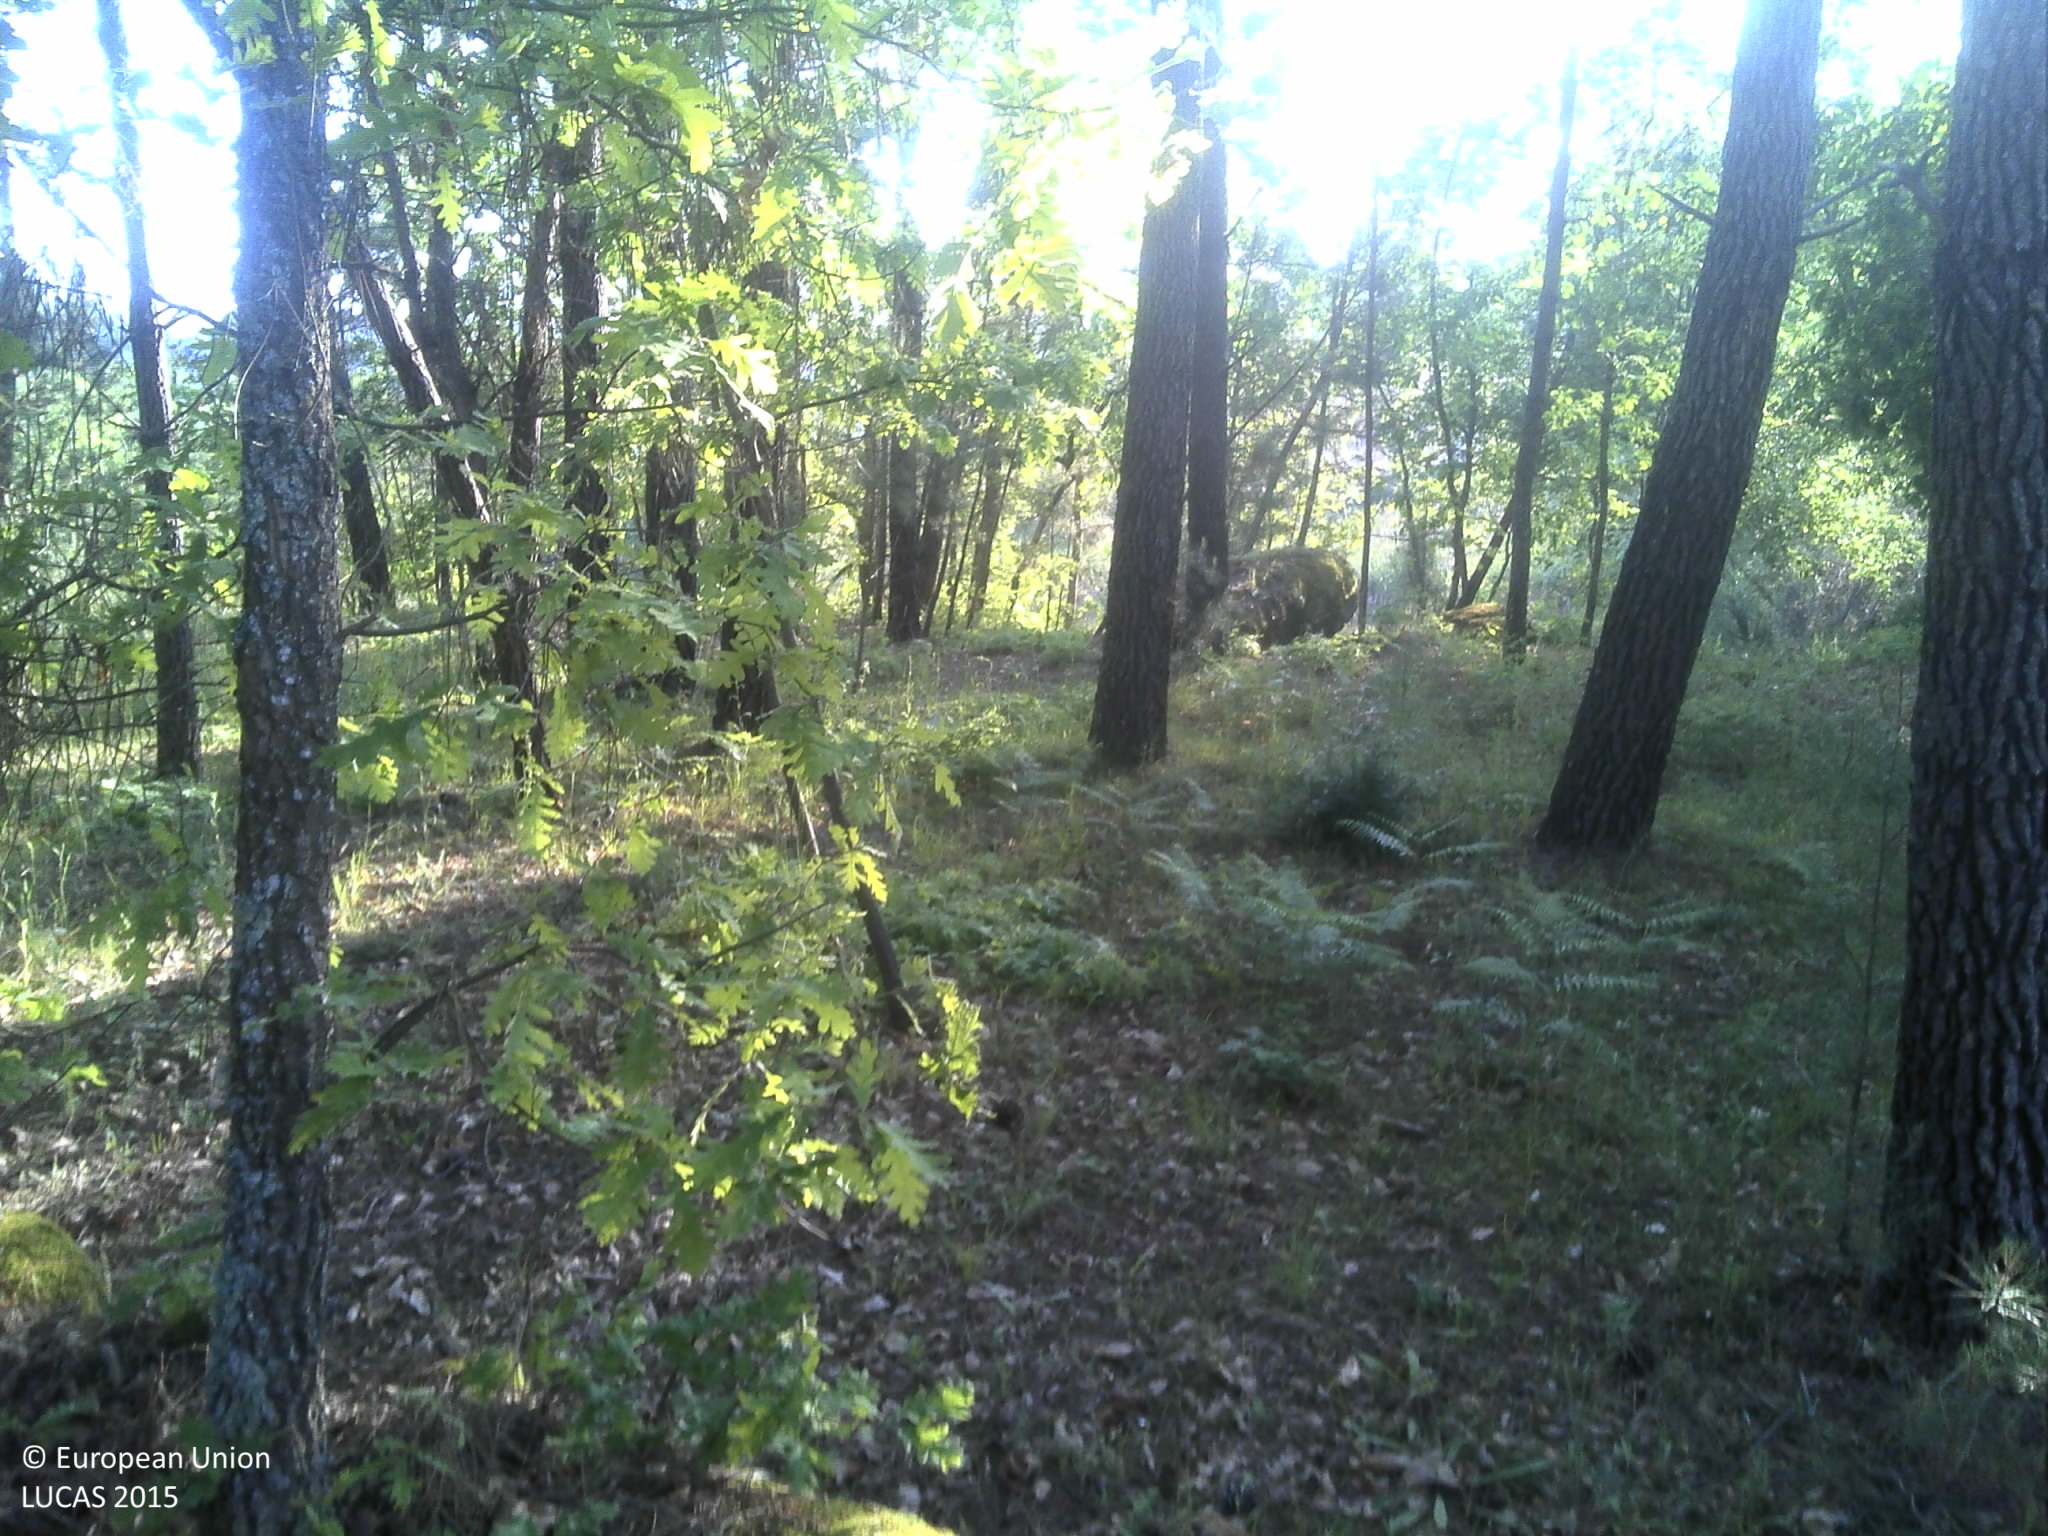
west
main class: Woodland
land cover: Pine dominated coniferous woodland
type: coniferous forest of the mediterranean region
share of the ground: 50 - 75 %
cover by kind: coniferous forest trees 100 %
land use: Forestry
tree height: > 5 m
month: May
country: PT
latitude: 40.6424
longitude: -7.7749
